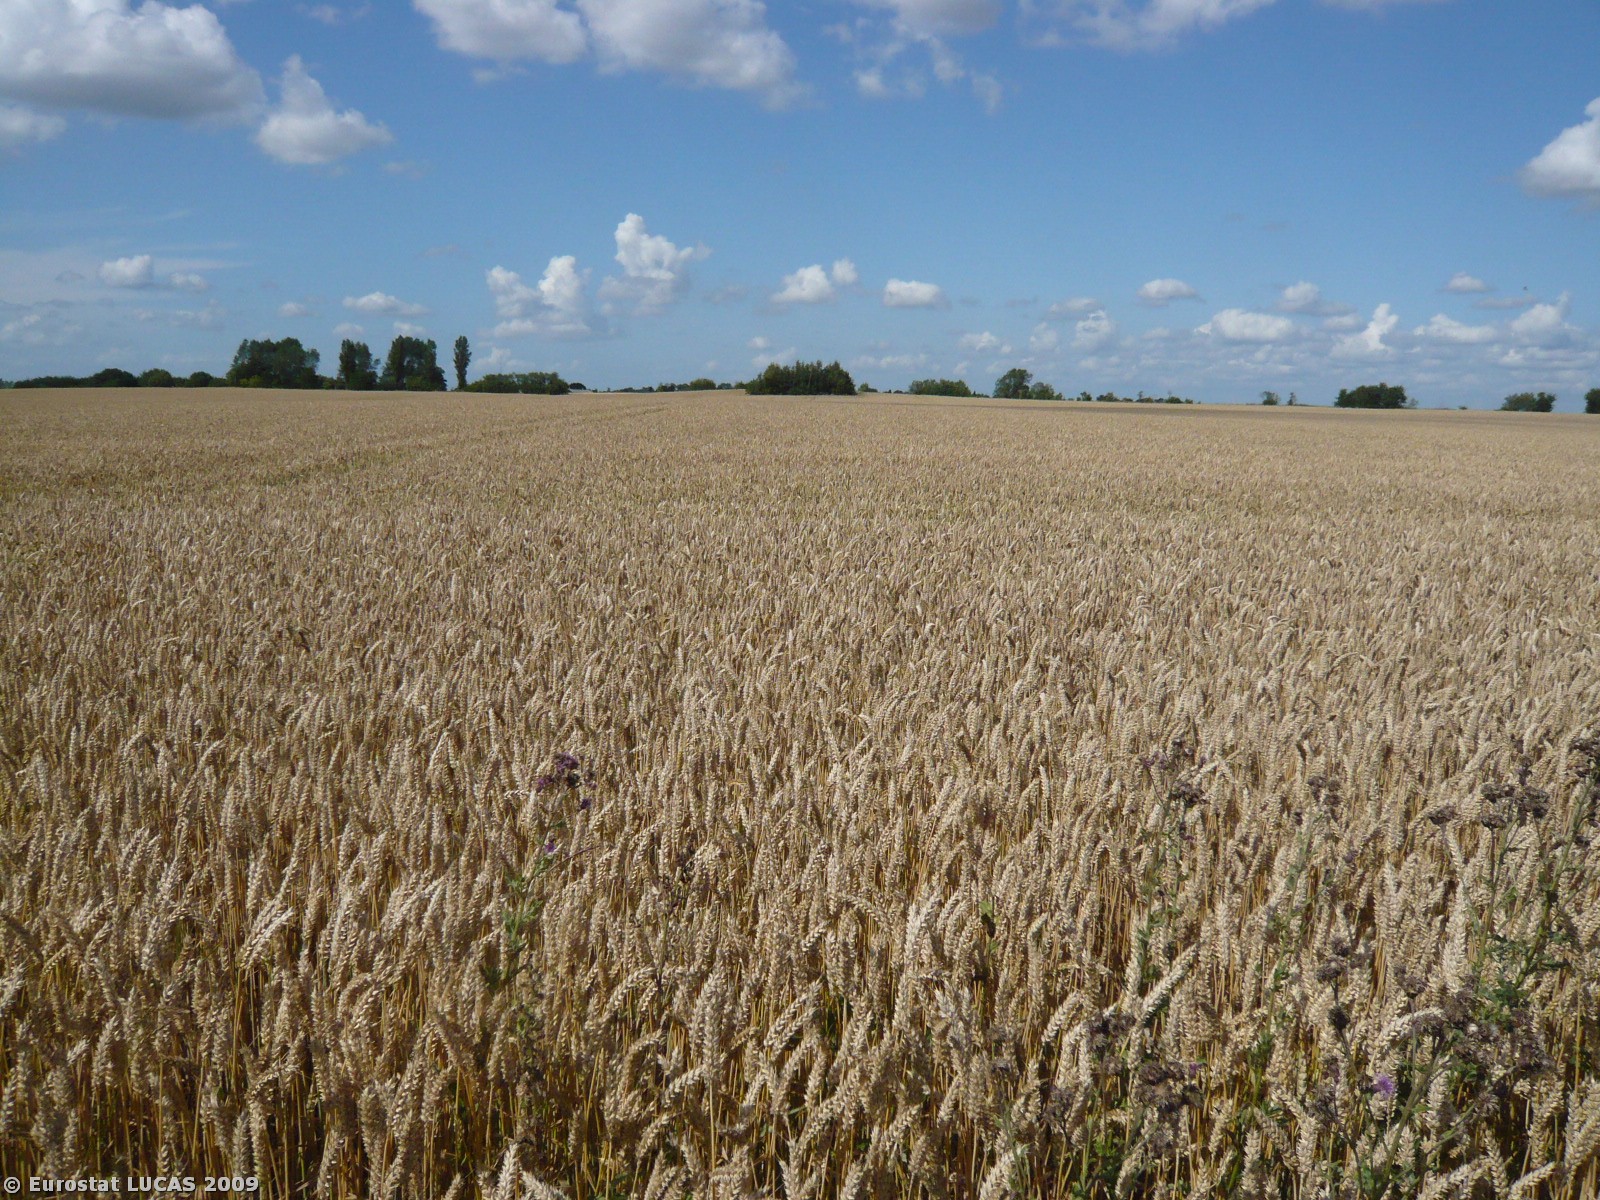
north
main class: Cropland
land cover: Common wheat
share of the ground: > 75 %
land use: Agriculture (excluding fallow land and kitchen gardens)
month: July
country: DK
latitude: 55.5760
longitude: 12.1712
